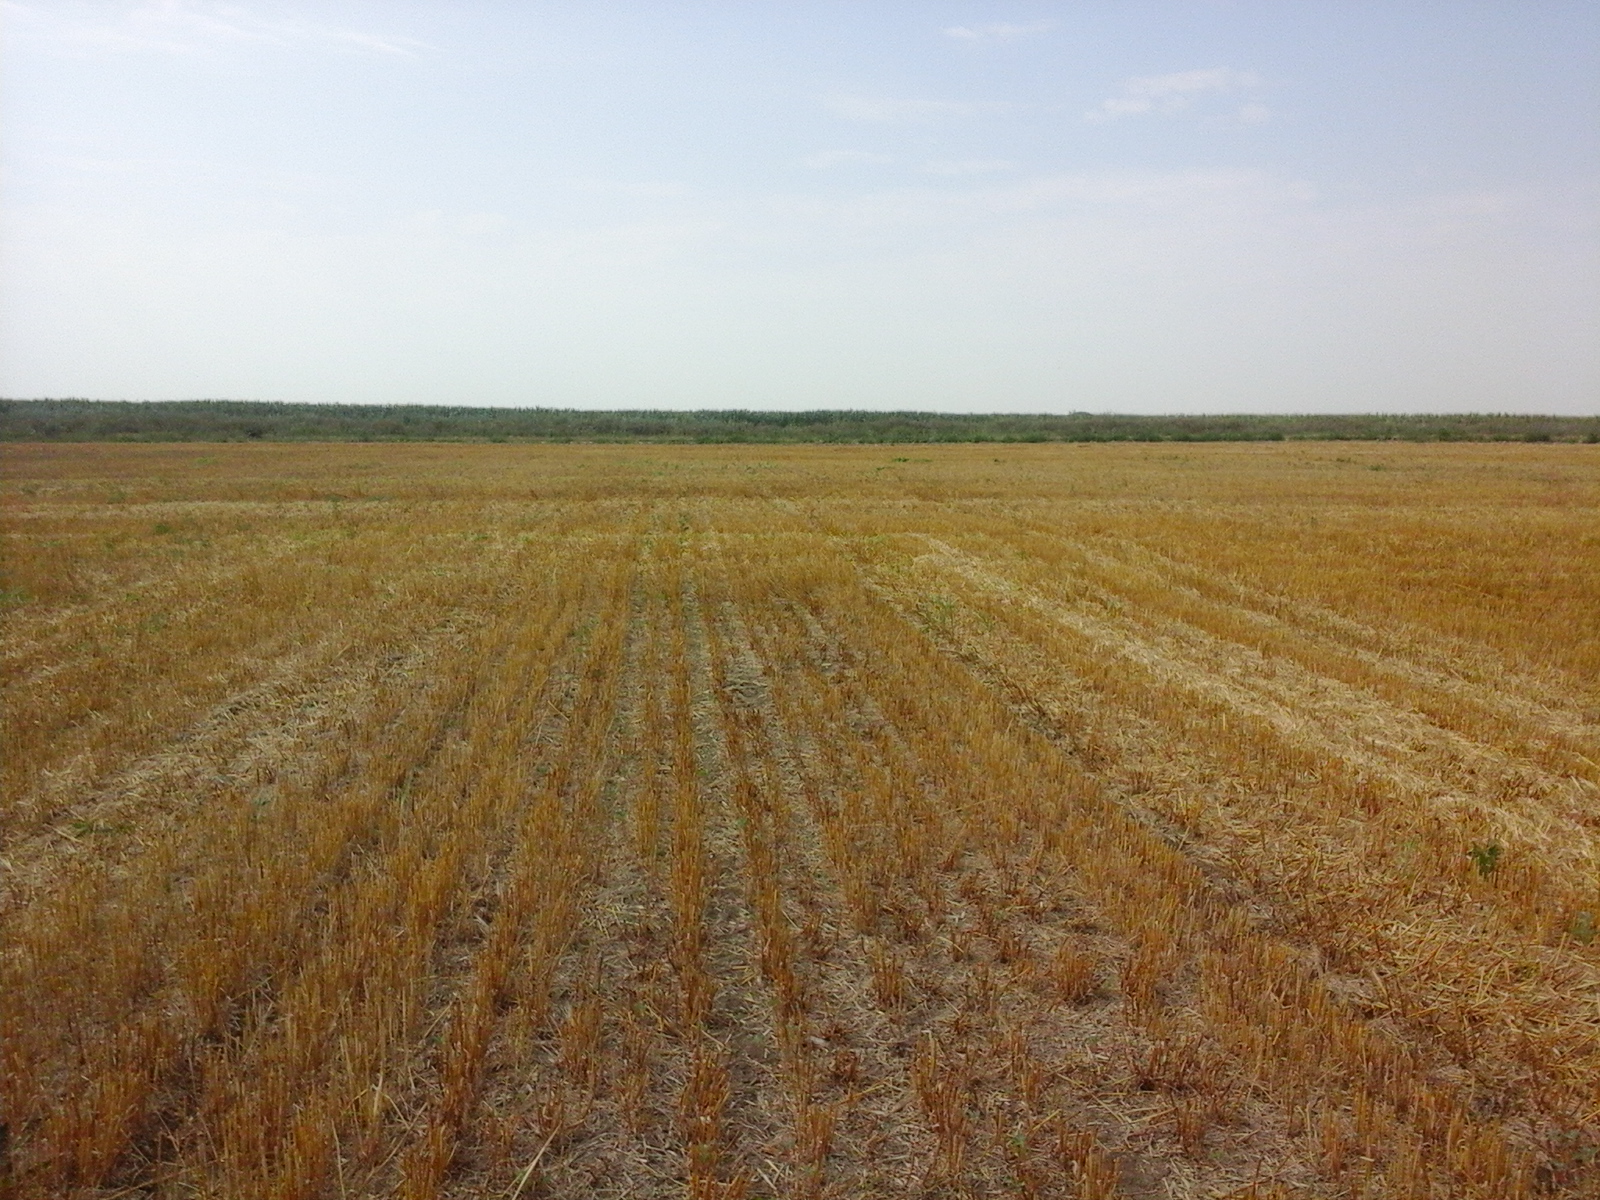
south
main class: Cropland
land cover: Common wheat
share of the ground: > 75 %
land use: Agriculture (excluding fallow land and kitchen gardens)
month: July
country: RO
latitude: 44.4763
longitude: 27.9970
